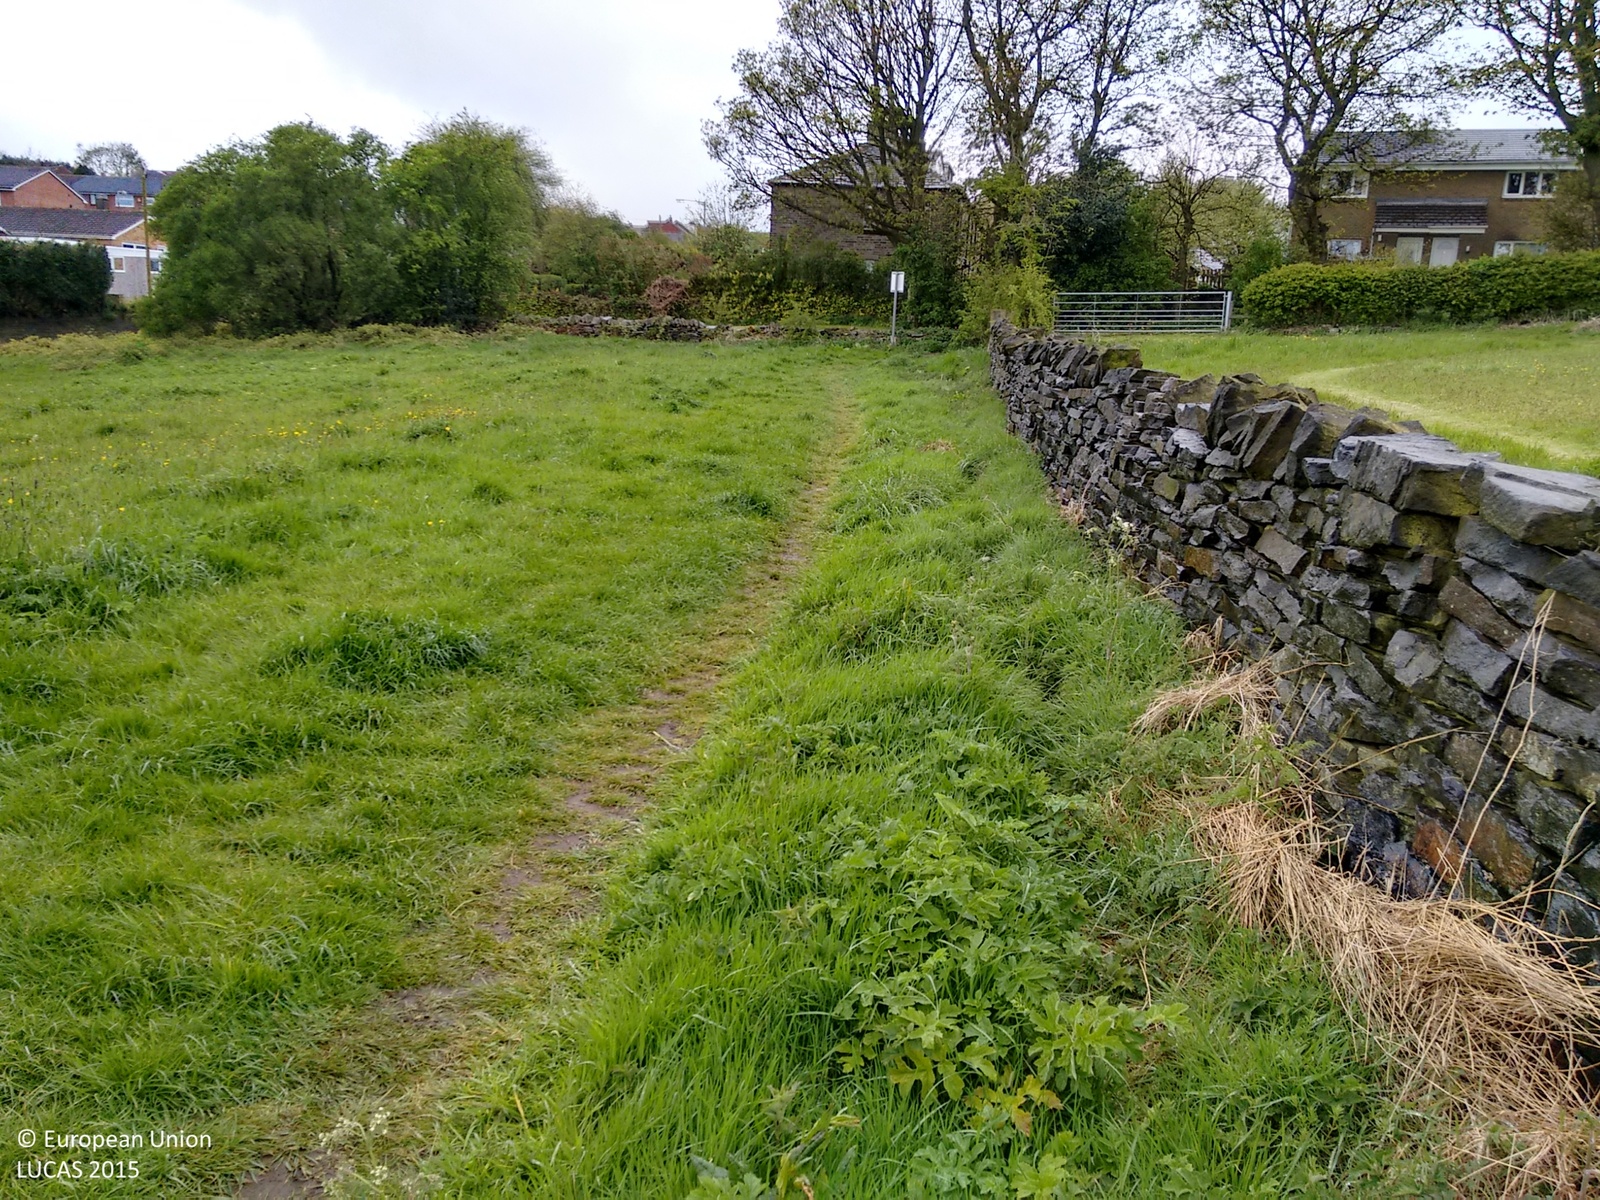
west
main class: Grassland
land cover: Grassland without tree/shrub cover
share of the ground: > 75 %
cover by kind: herbaceous plants 100 %
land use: Agriculture (excluding fallow land and kitchen gardens)
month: May
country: GB
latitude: 53.7108
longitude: -1.8267
